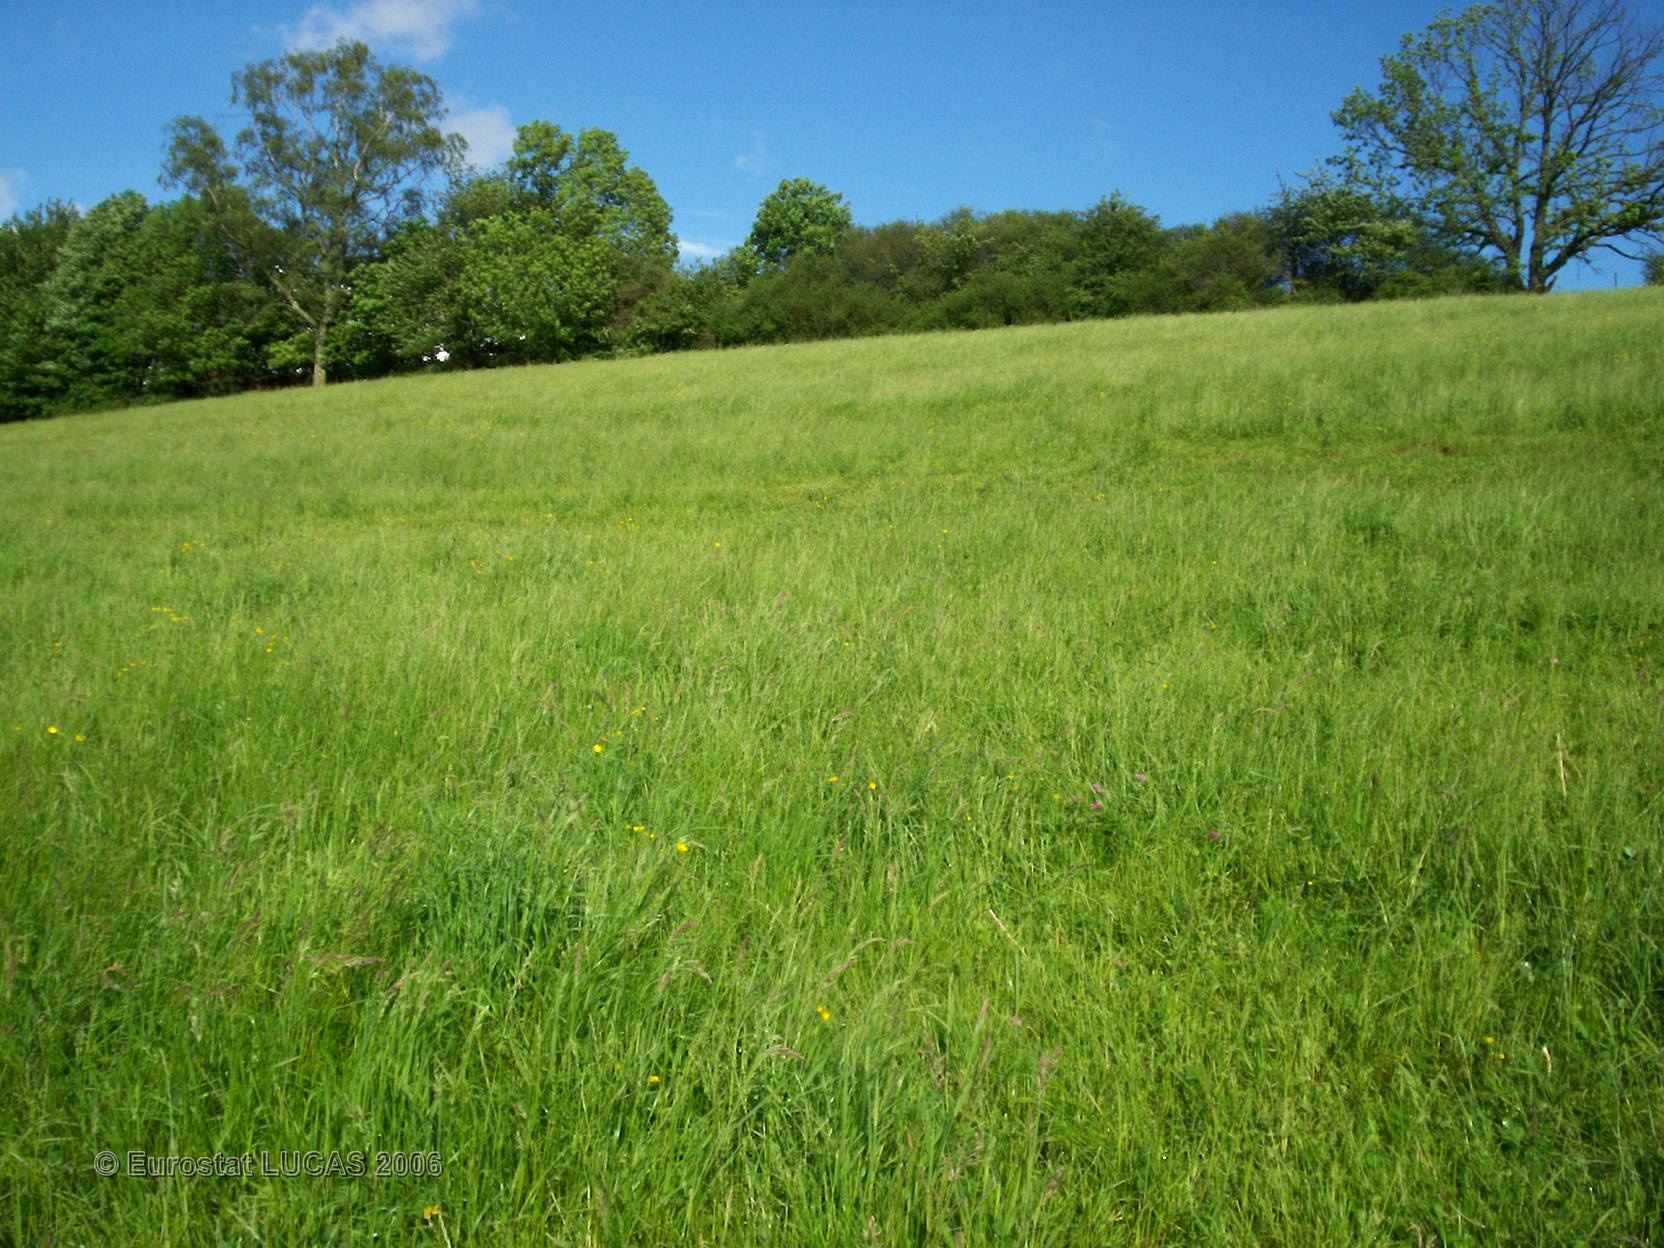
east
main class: Grassland
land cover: Grassland without tree/shrub cover
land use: Agriculture (excluding fallow land and kitchen gardens)
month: May
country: FR
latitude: 48.3079
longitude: 6.9672
